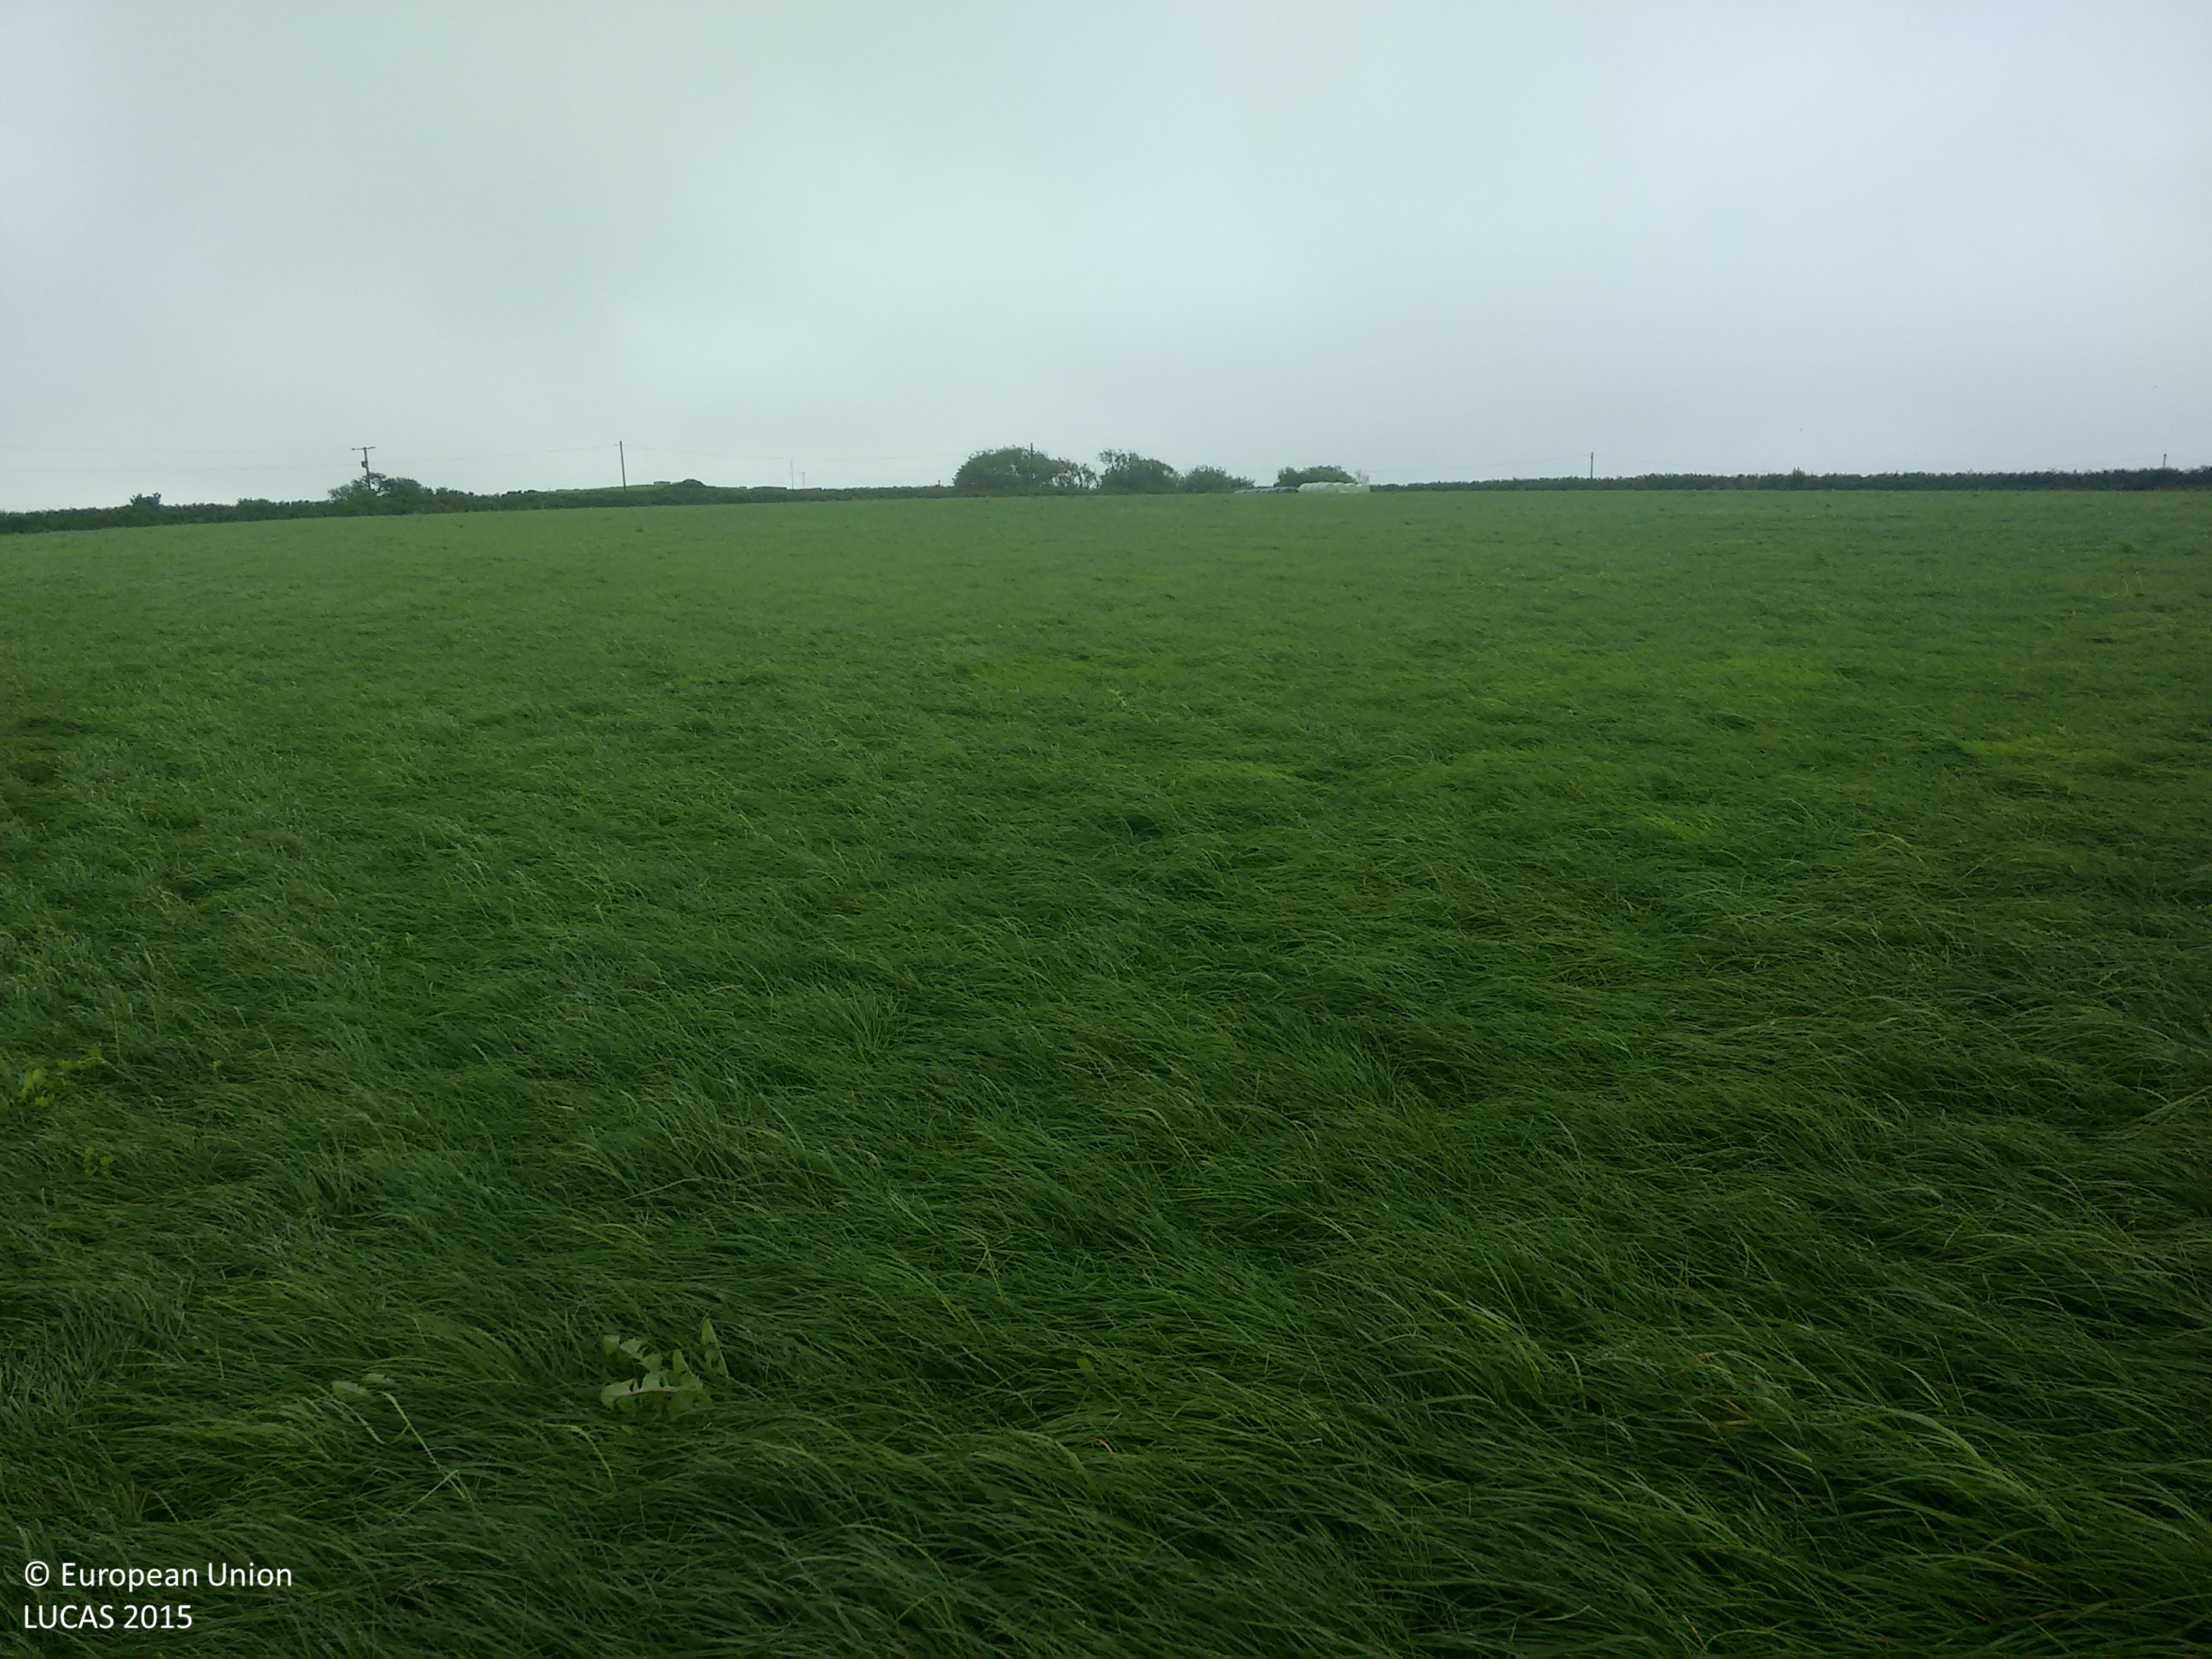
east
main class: Grassland
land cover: Grassland without tree/shrub cover
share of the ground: > 75 %
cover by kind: herbaceous plants 100 %
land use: Agriculture (excluding fallow land and kitchen gardens)
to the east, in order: Grassland without tree/shrub cover; Managed hedges; Paved roads, cycling and walking lanes; Electric lines; Managed hedges; Spontaneously vegetated surfaces; Tracks; Spontaneously vegetated surfaces; Managed hedges; Fences; Temporary grasslands
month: August
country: GB
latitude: 50.0665
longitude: -5.1080
